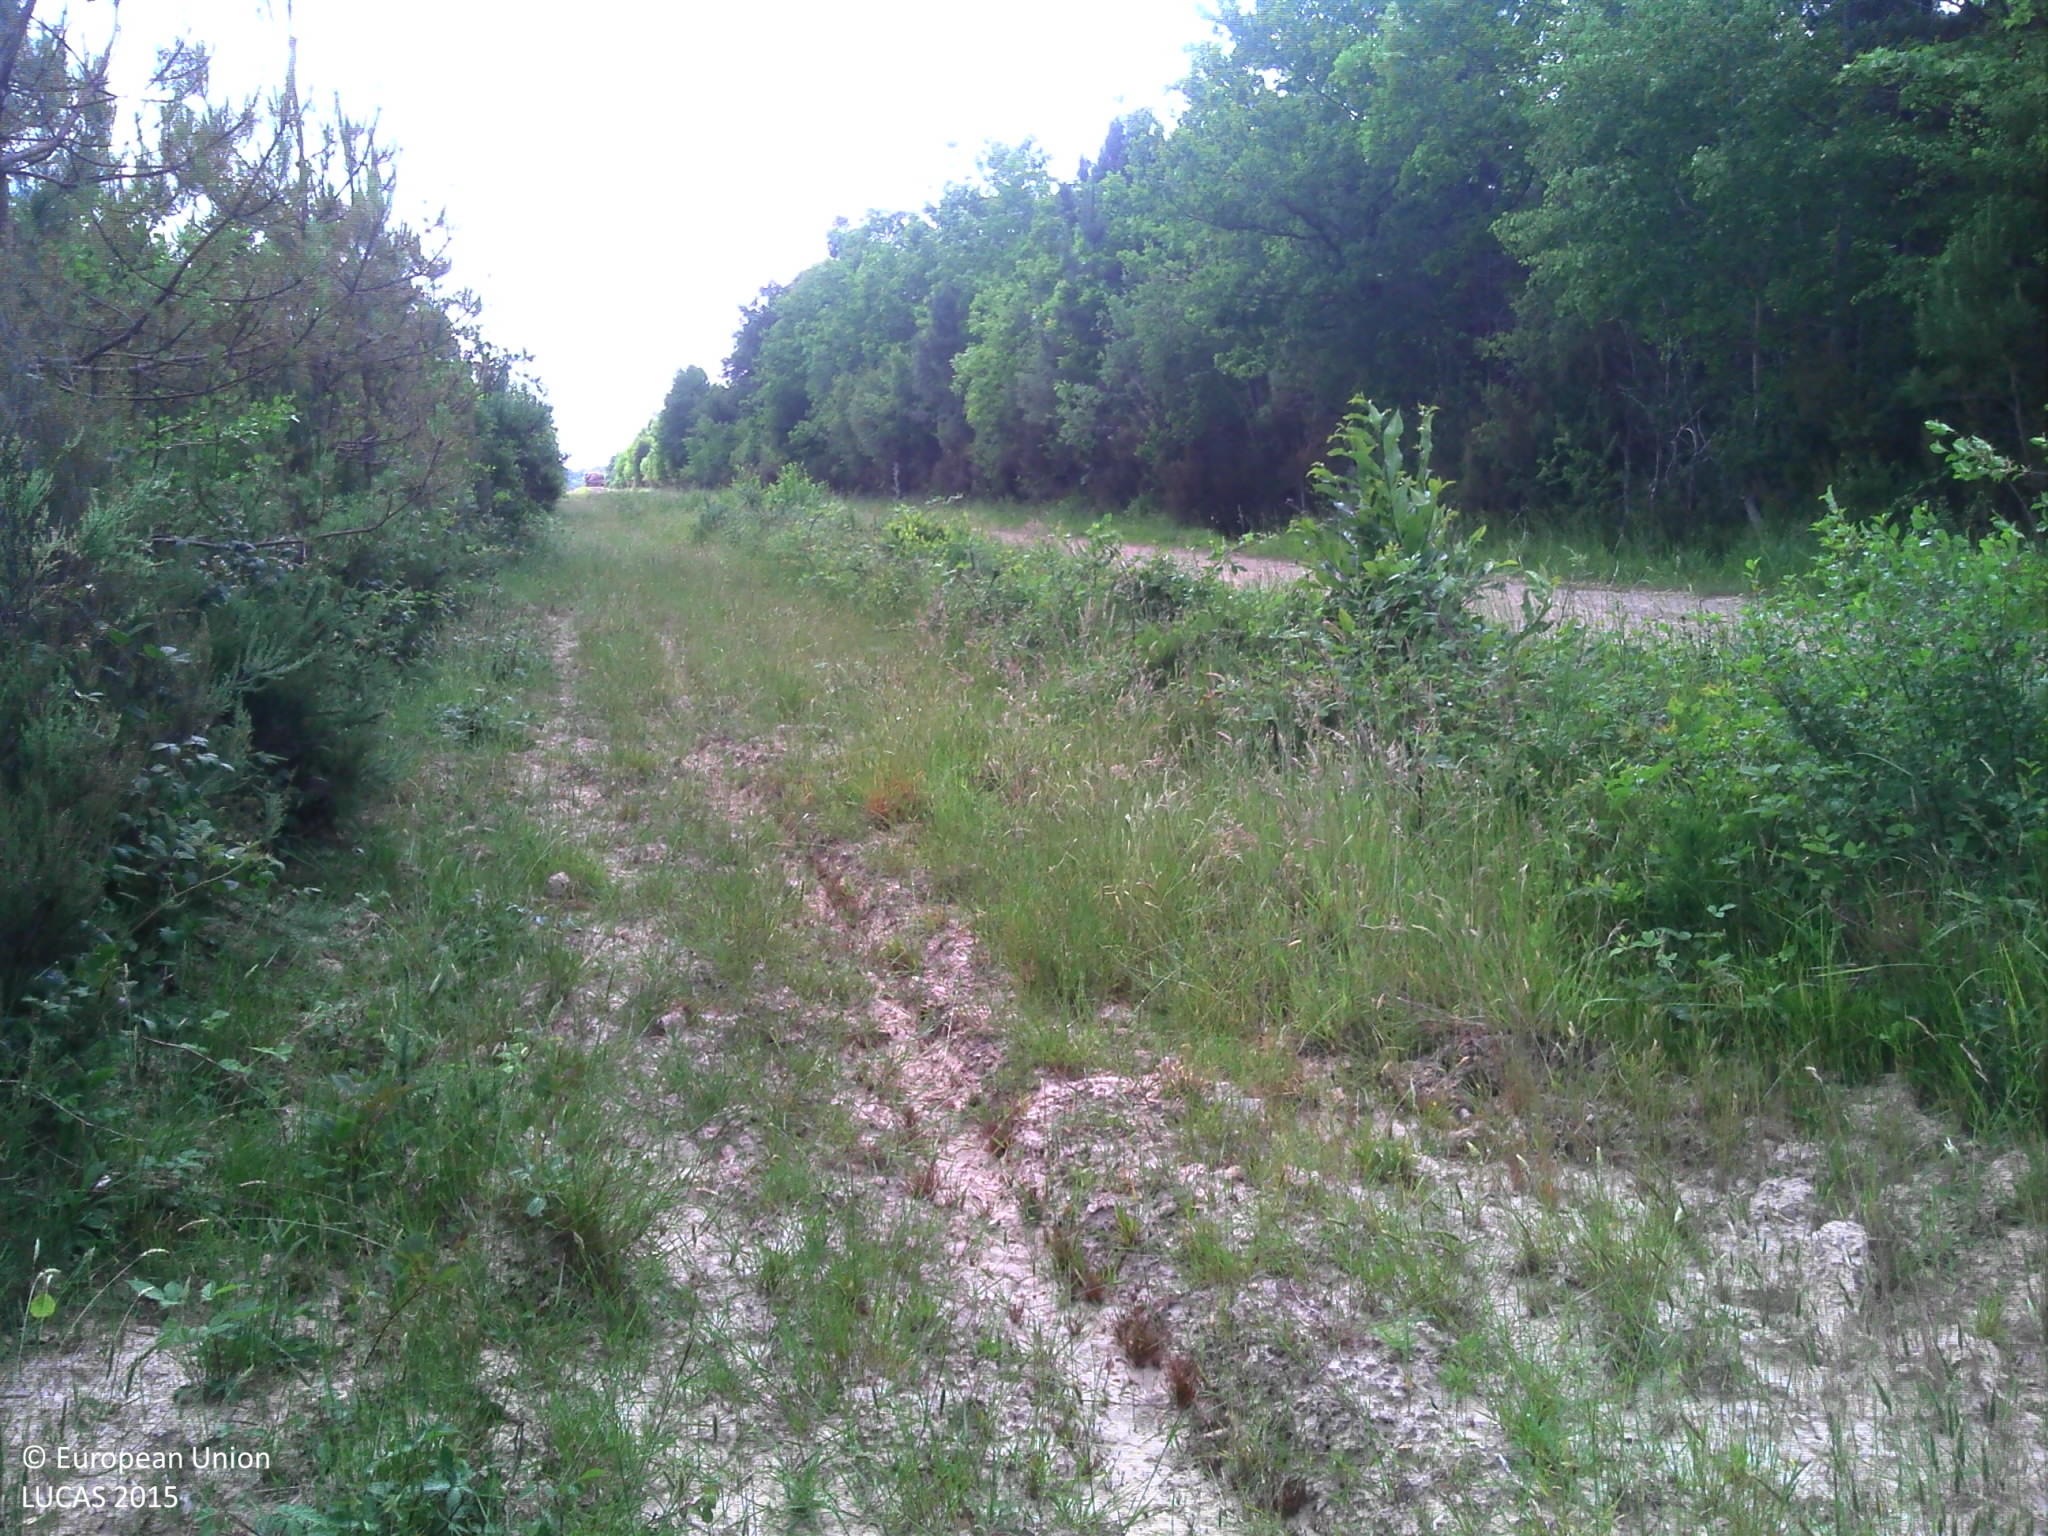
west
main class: Woodland
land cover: Pine dominated coniferous woodland
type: exotic forest
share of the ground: > 75 %
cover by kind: coniferous forest trees 75 %, shrubs 20 %, broadleaved forest trees 5 %
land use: Forestry
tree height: > 5 m
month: June
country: FR
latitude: 47.5928
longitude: 0.6840
